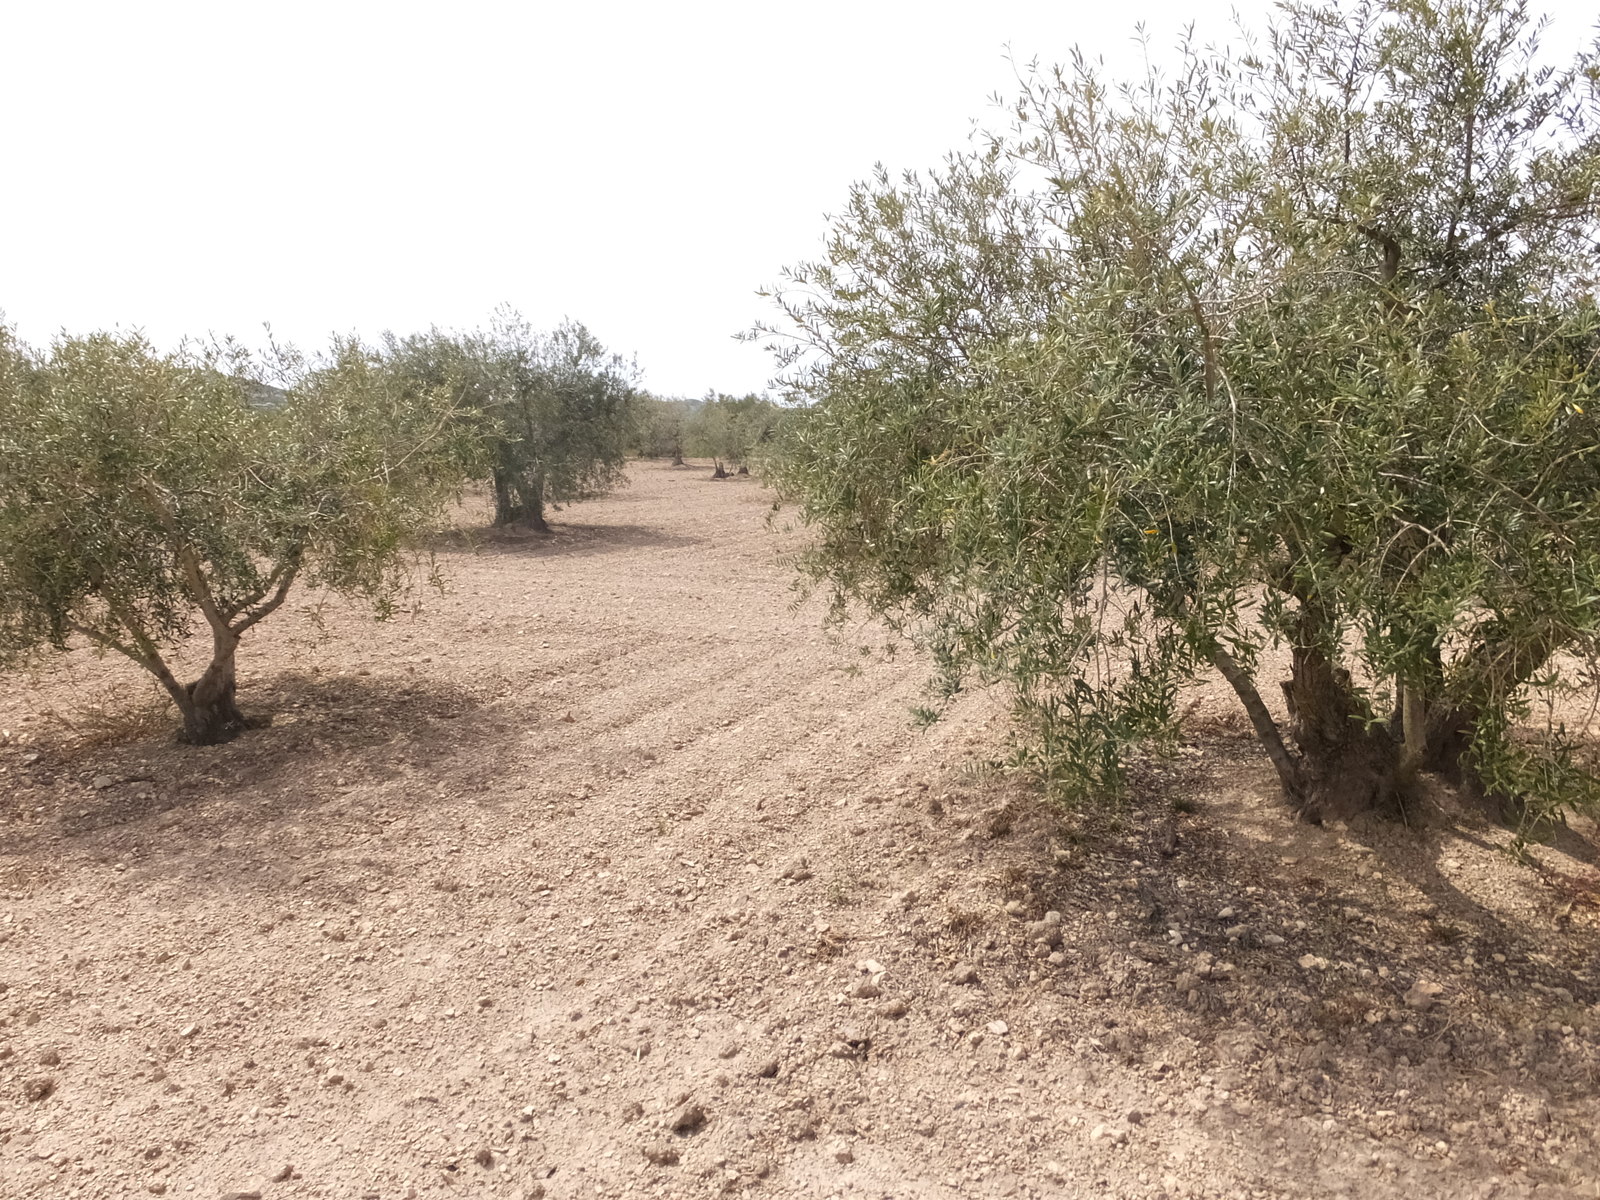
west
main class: Cropland
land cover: Olive groves
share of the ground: 10 - 25 %
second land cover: Other bare soil
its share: > 75 %
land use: Agriculture (excluding fallow land and kitchen gardens)
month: April
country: ES
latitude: 41.5918
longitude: -0.2015
